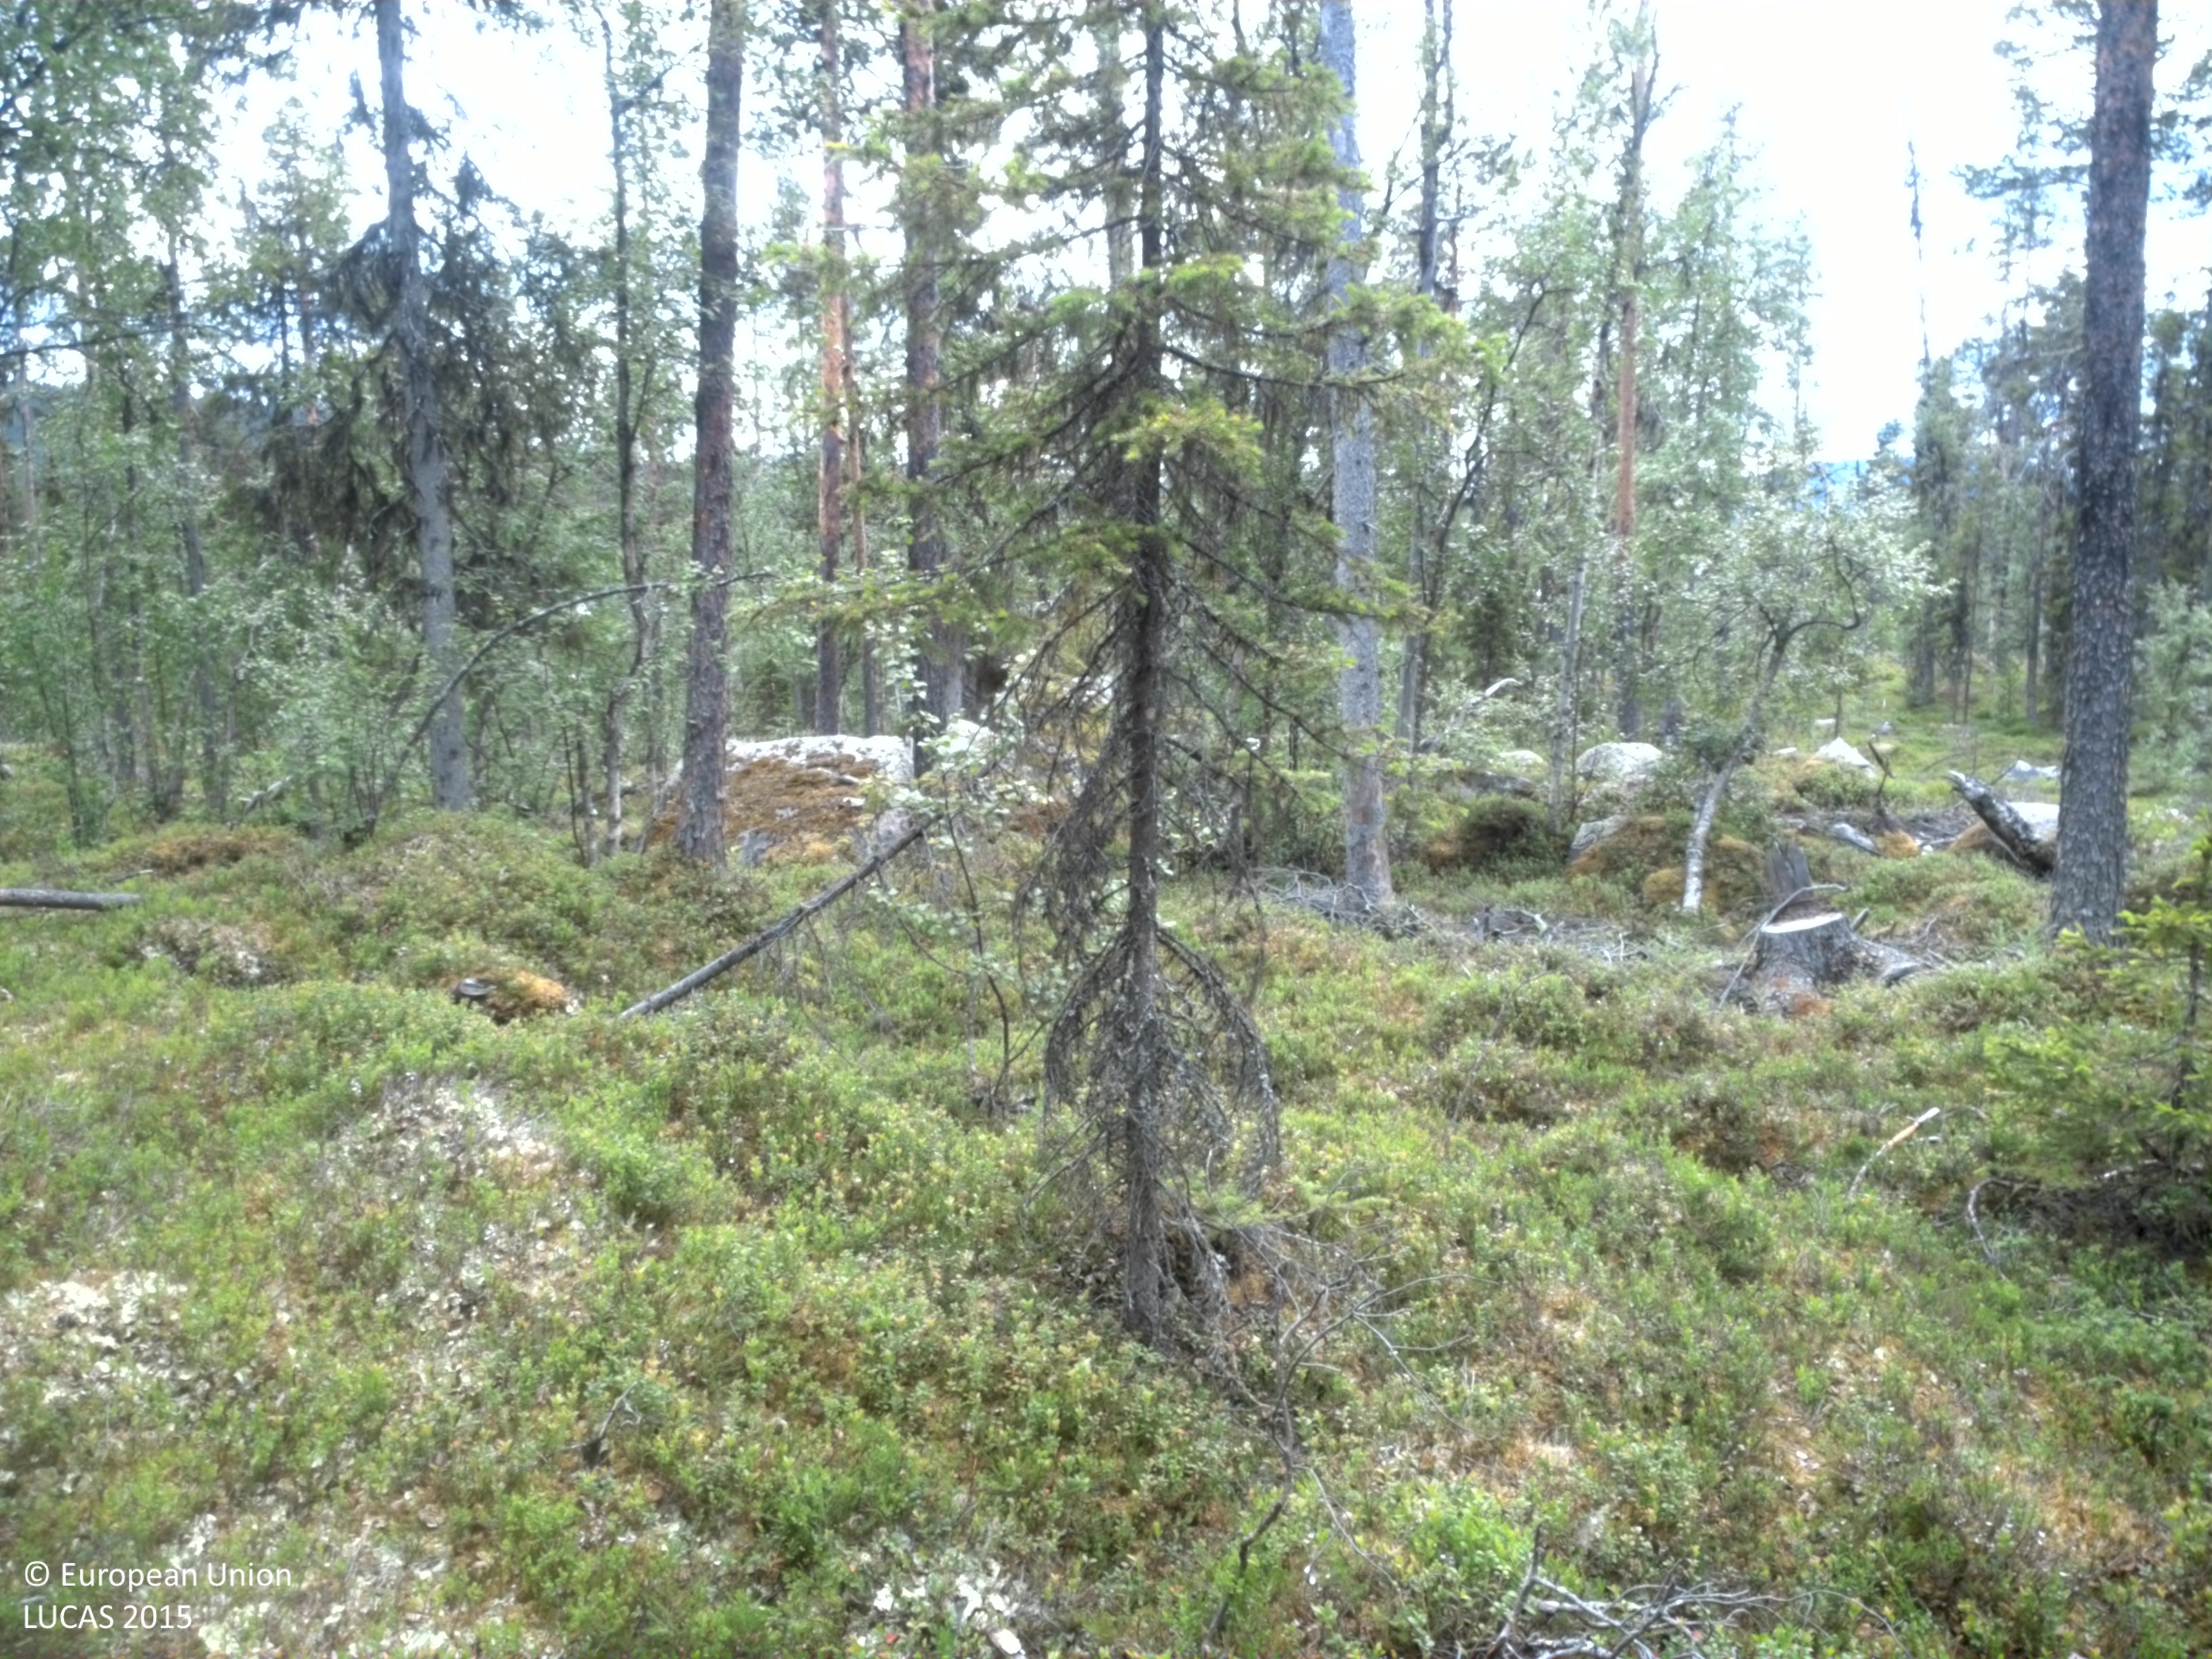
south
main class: Woodland
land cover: Pine dominated coniferous woodland
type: boreal forest
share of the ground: 25 - 50 %
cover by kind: shrubs 50 %, coniferous forest trees 35 %, consolidated bare surface 10 %, broadleaved forest trees 5 %
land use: Forestry
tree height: > 5 m
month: July
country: SE
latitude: 66.8929
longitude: 18.2819
